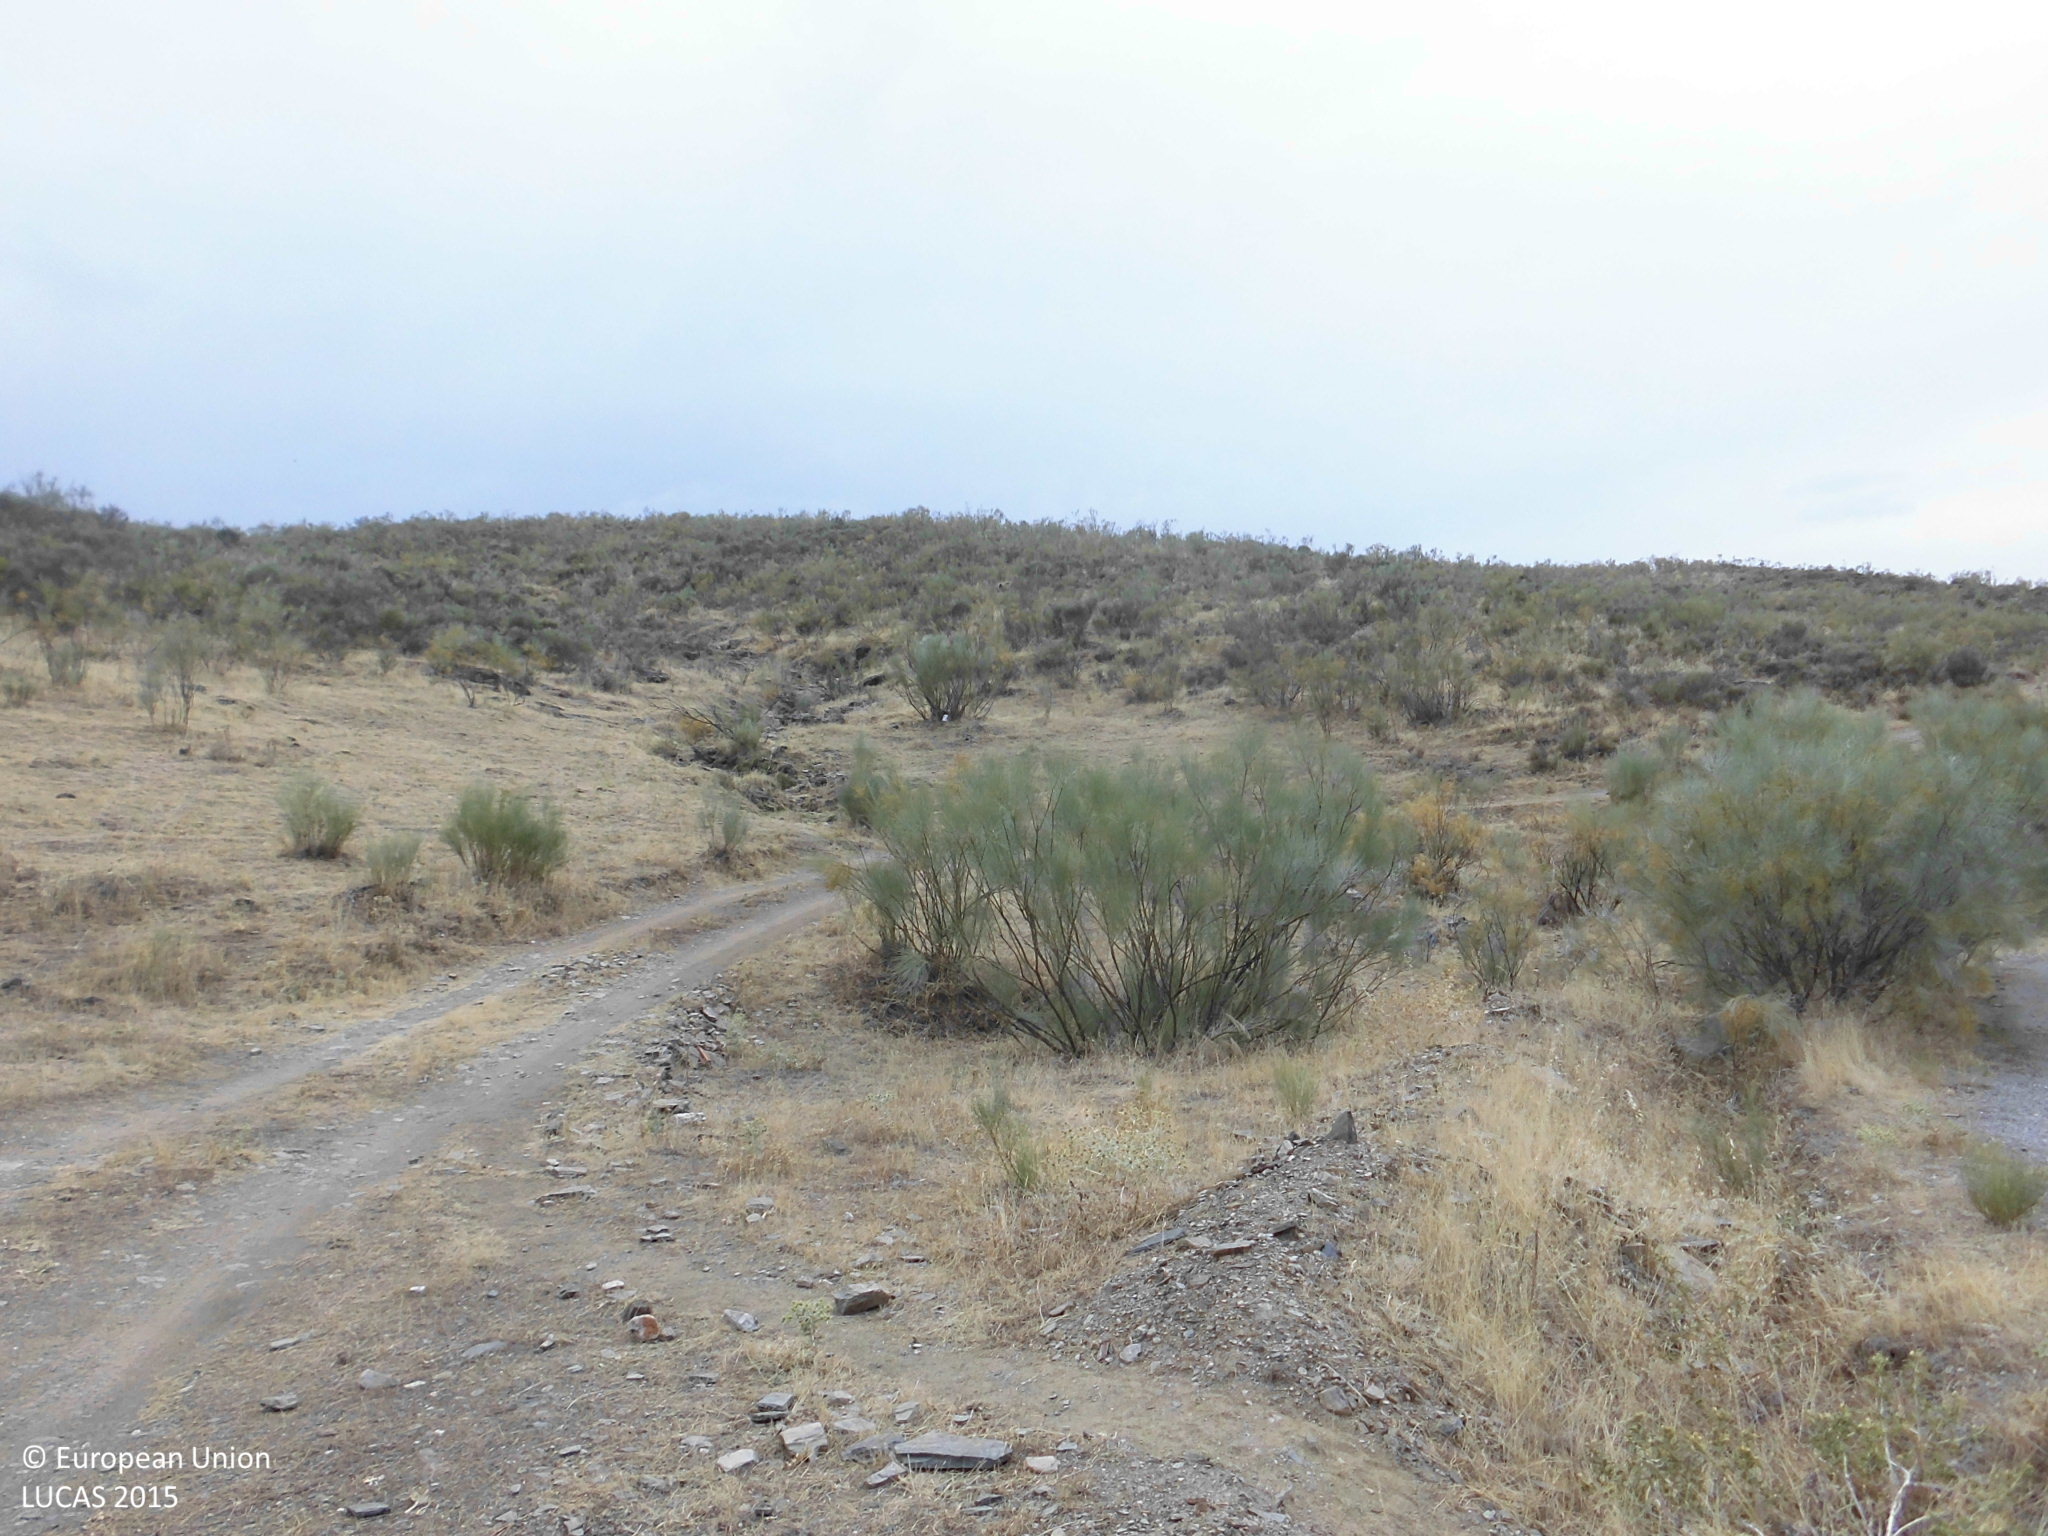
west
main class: Shrubland
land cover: Shrubland without tree cover
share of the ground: 25 - 50 %
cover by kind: shrubs 50 %, herbaceous plants 50 %
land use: Agriculture (excluding fallow land and kitchen gardens)
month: July
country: ES
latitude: 39.7581
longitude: -5.6410
